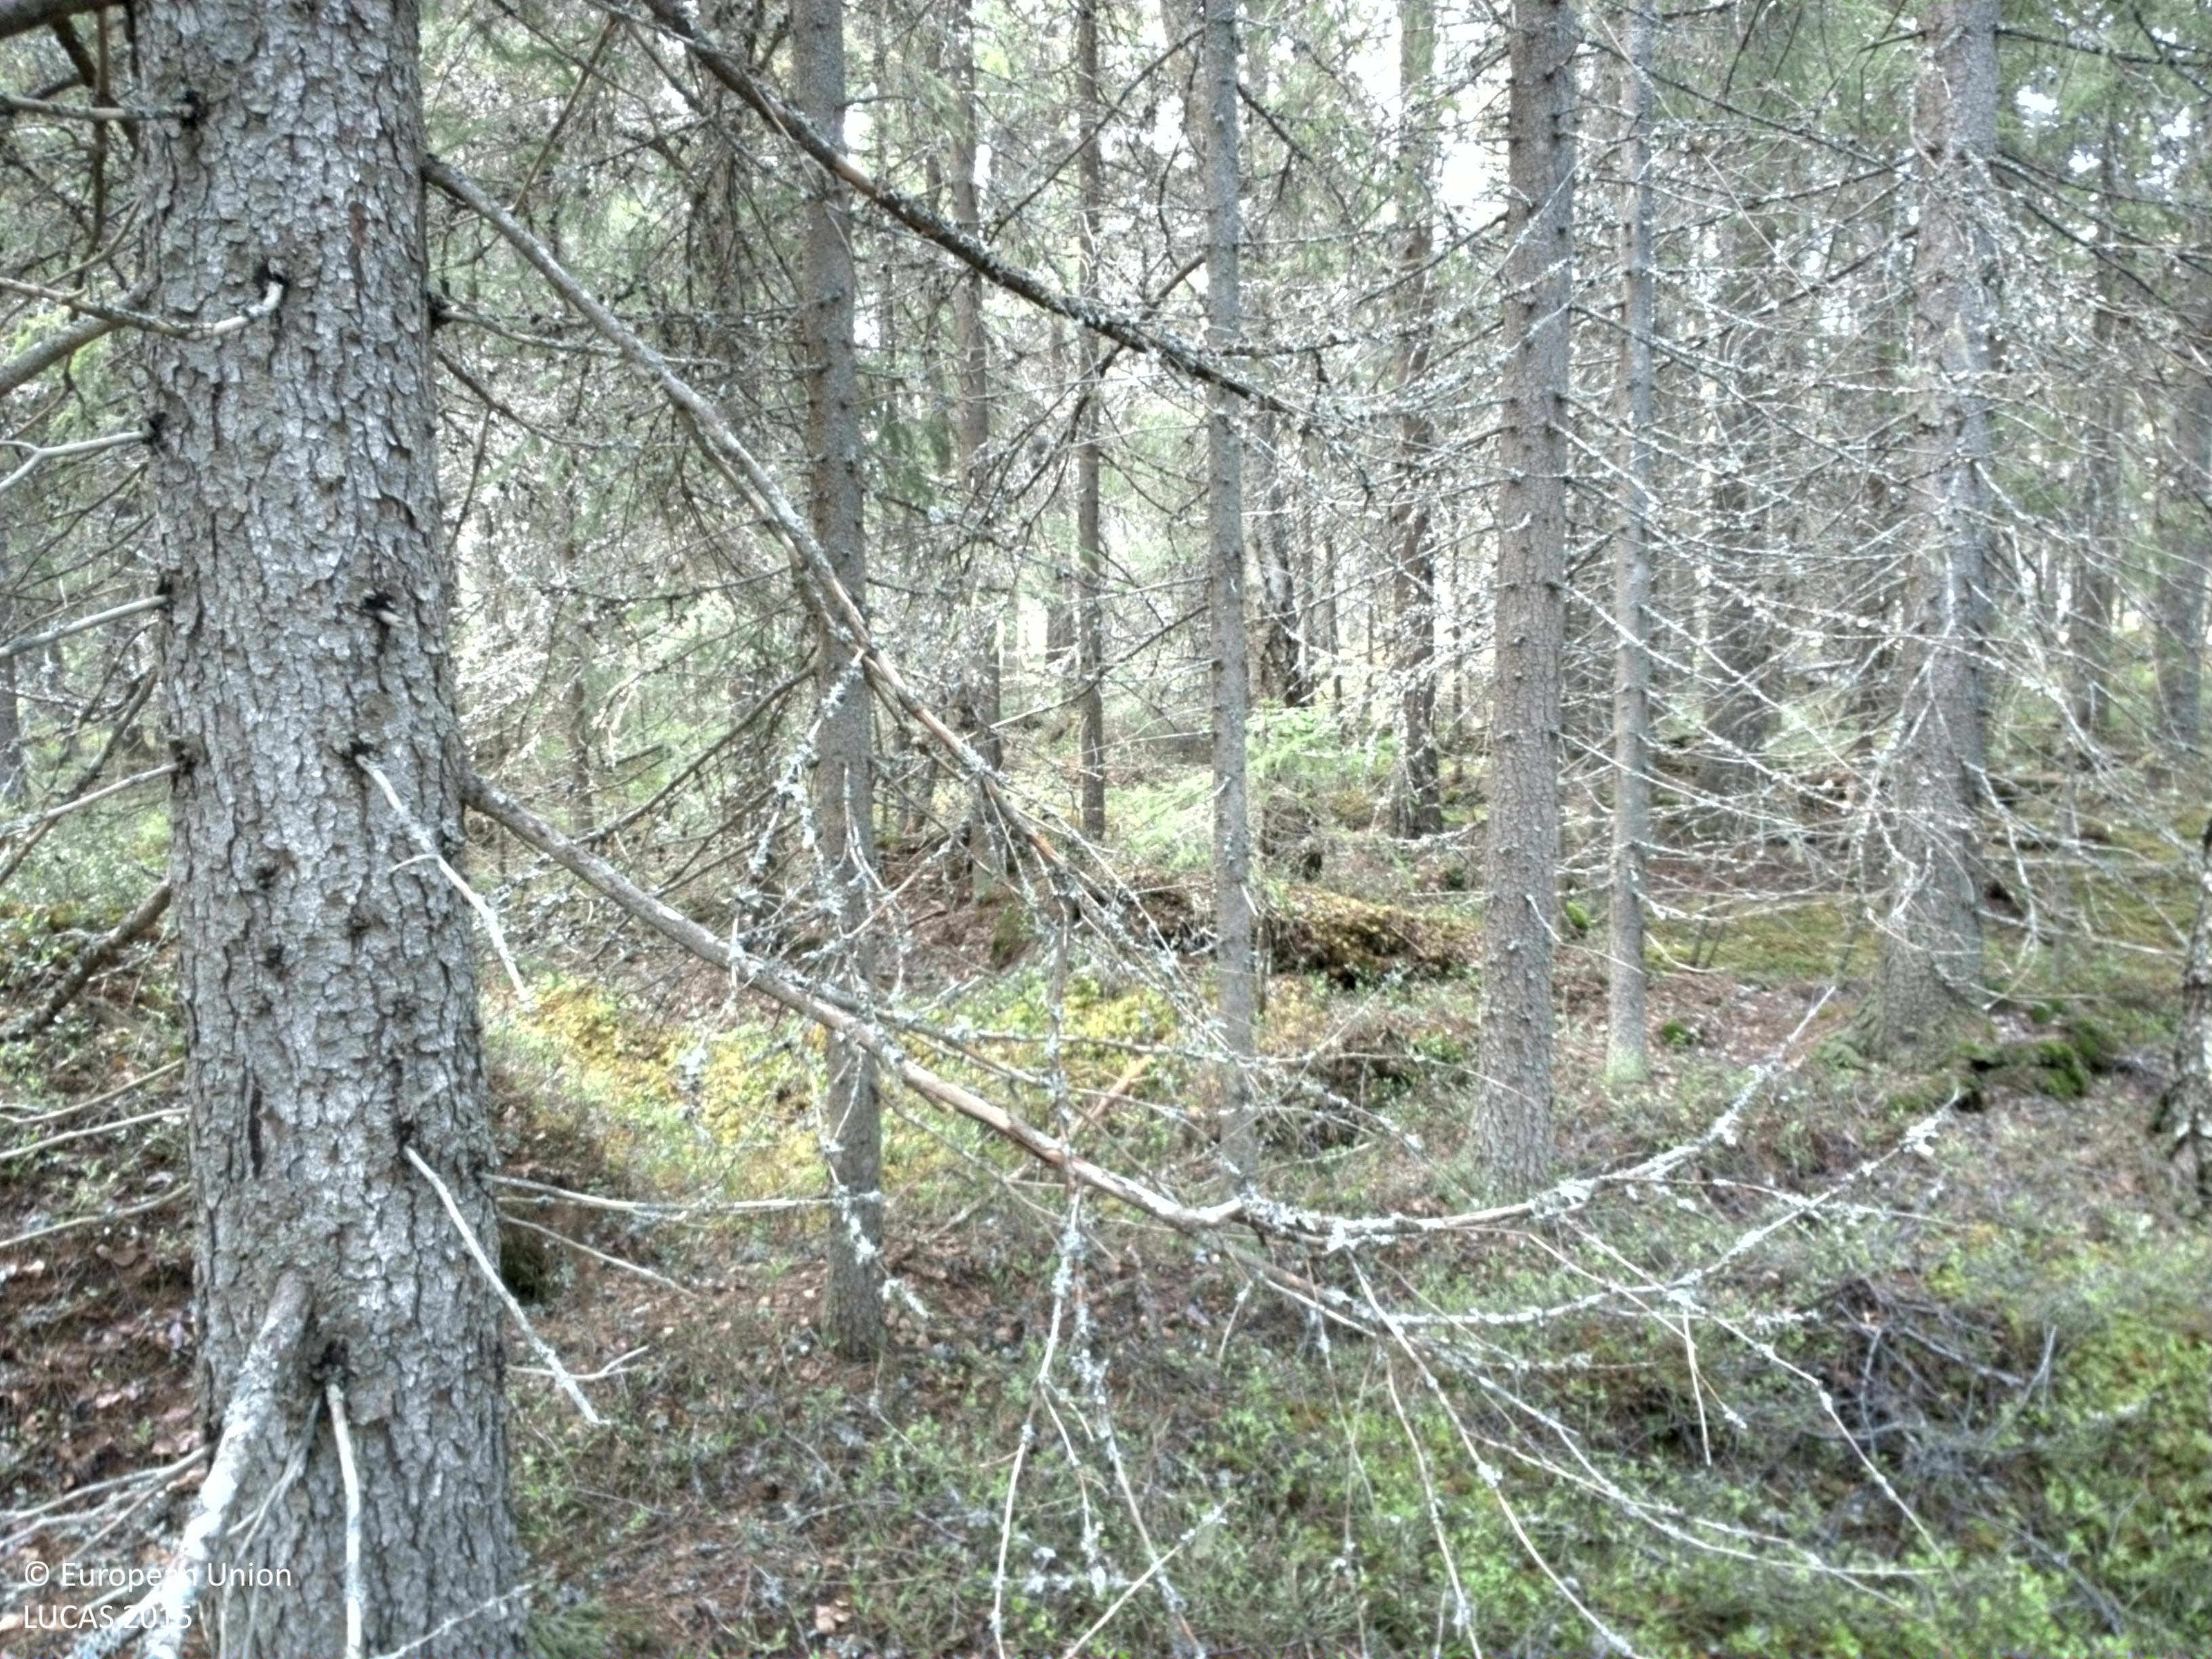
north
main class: Woodland
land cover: Spruce dominated coniferous woodland
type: boreal forest
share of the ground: 50 - 75 %
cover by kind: coniferous forest trees 70 %, shrubs 30 %
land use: Forestry
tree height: > 5 m
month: June
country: SE
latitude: 60.6115
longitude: 13.2600
